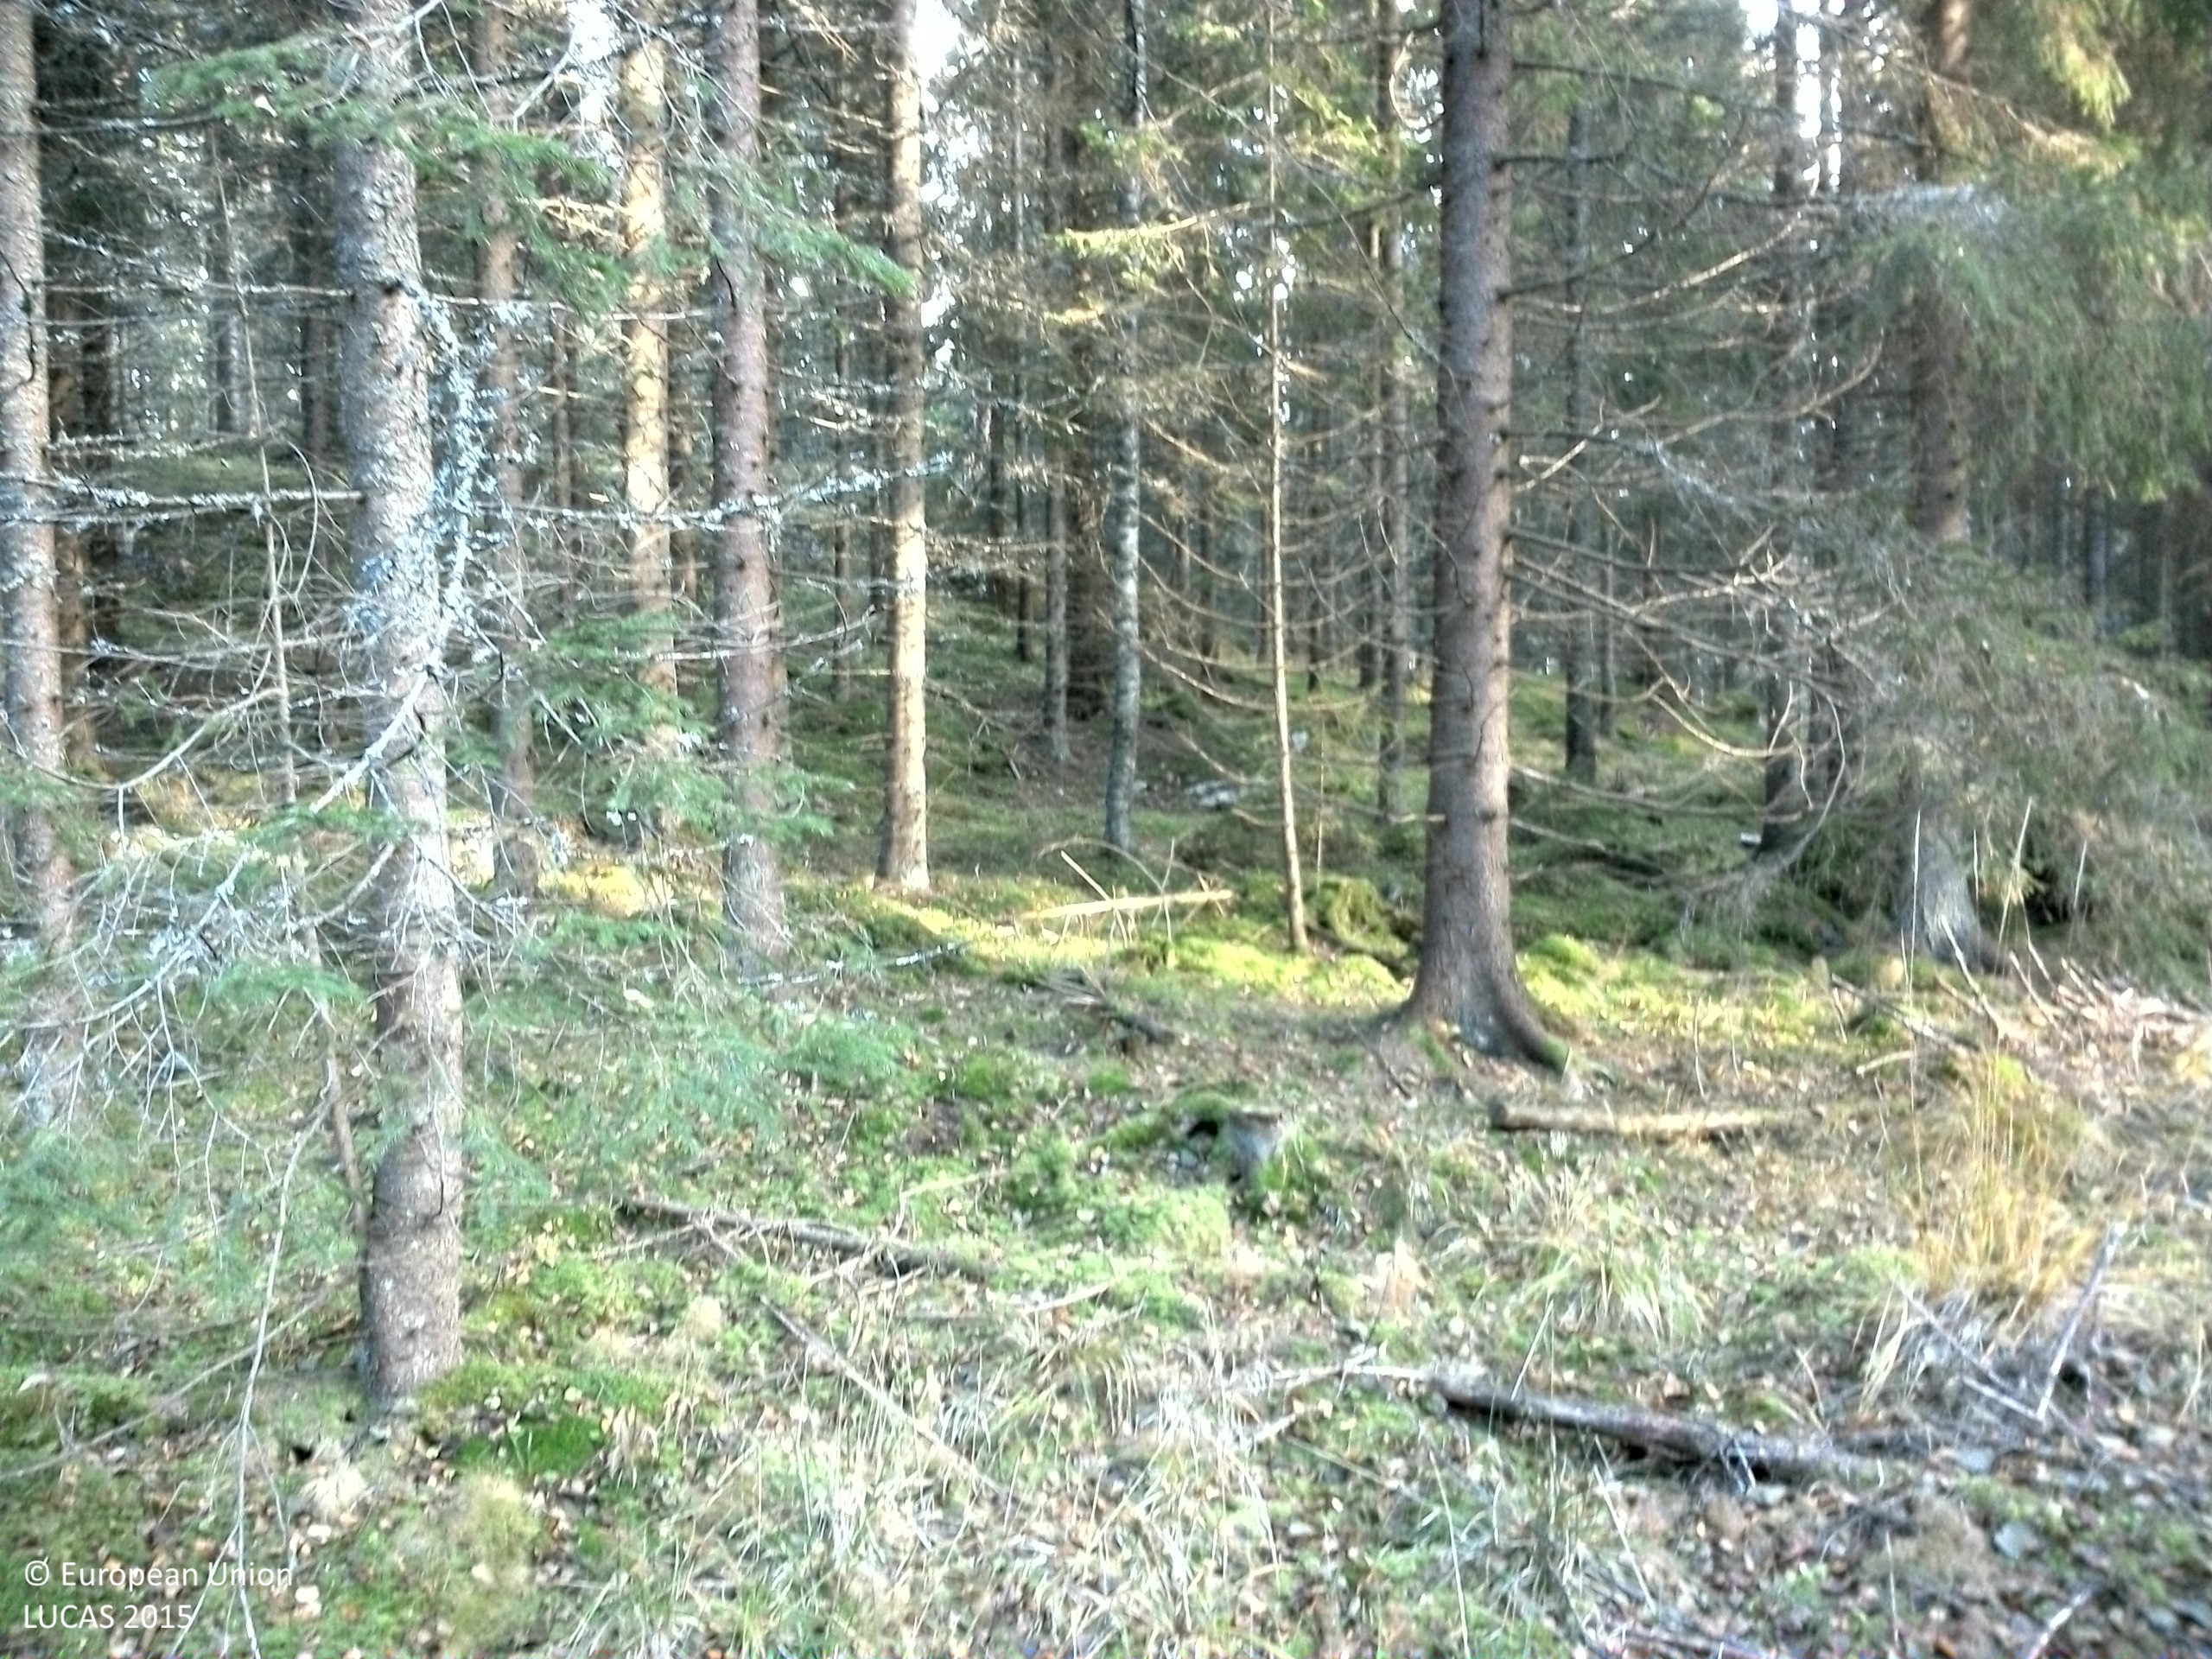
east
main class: Woodland
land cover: Other mixed woodland
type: boreal forest
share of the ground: 50 - 75 %
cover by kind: coniferous forest trees 35 %, broadleaved forest trees 30 %, shrubs 15 %, herbaceous plants 15 %, lichens and mosses 5 %
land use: Forestry
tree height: > 5 m
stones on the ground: < 10 %
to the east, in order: Other mixed woodland; Spruce dominated coniferous woodland; Tracks; Spruce dominated mixed woodland; Other mixed woodland; Spruce dominated coniferous woodland; Spruce dominated mixed woodland; Spruce dominated coniferous woodland; Broadleaved woodland
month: November
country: SE
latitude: 57.9447
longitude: 14.5390
